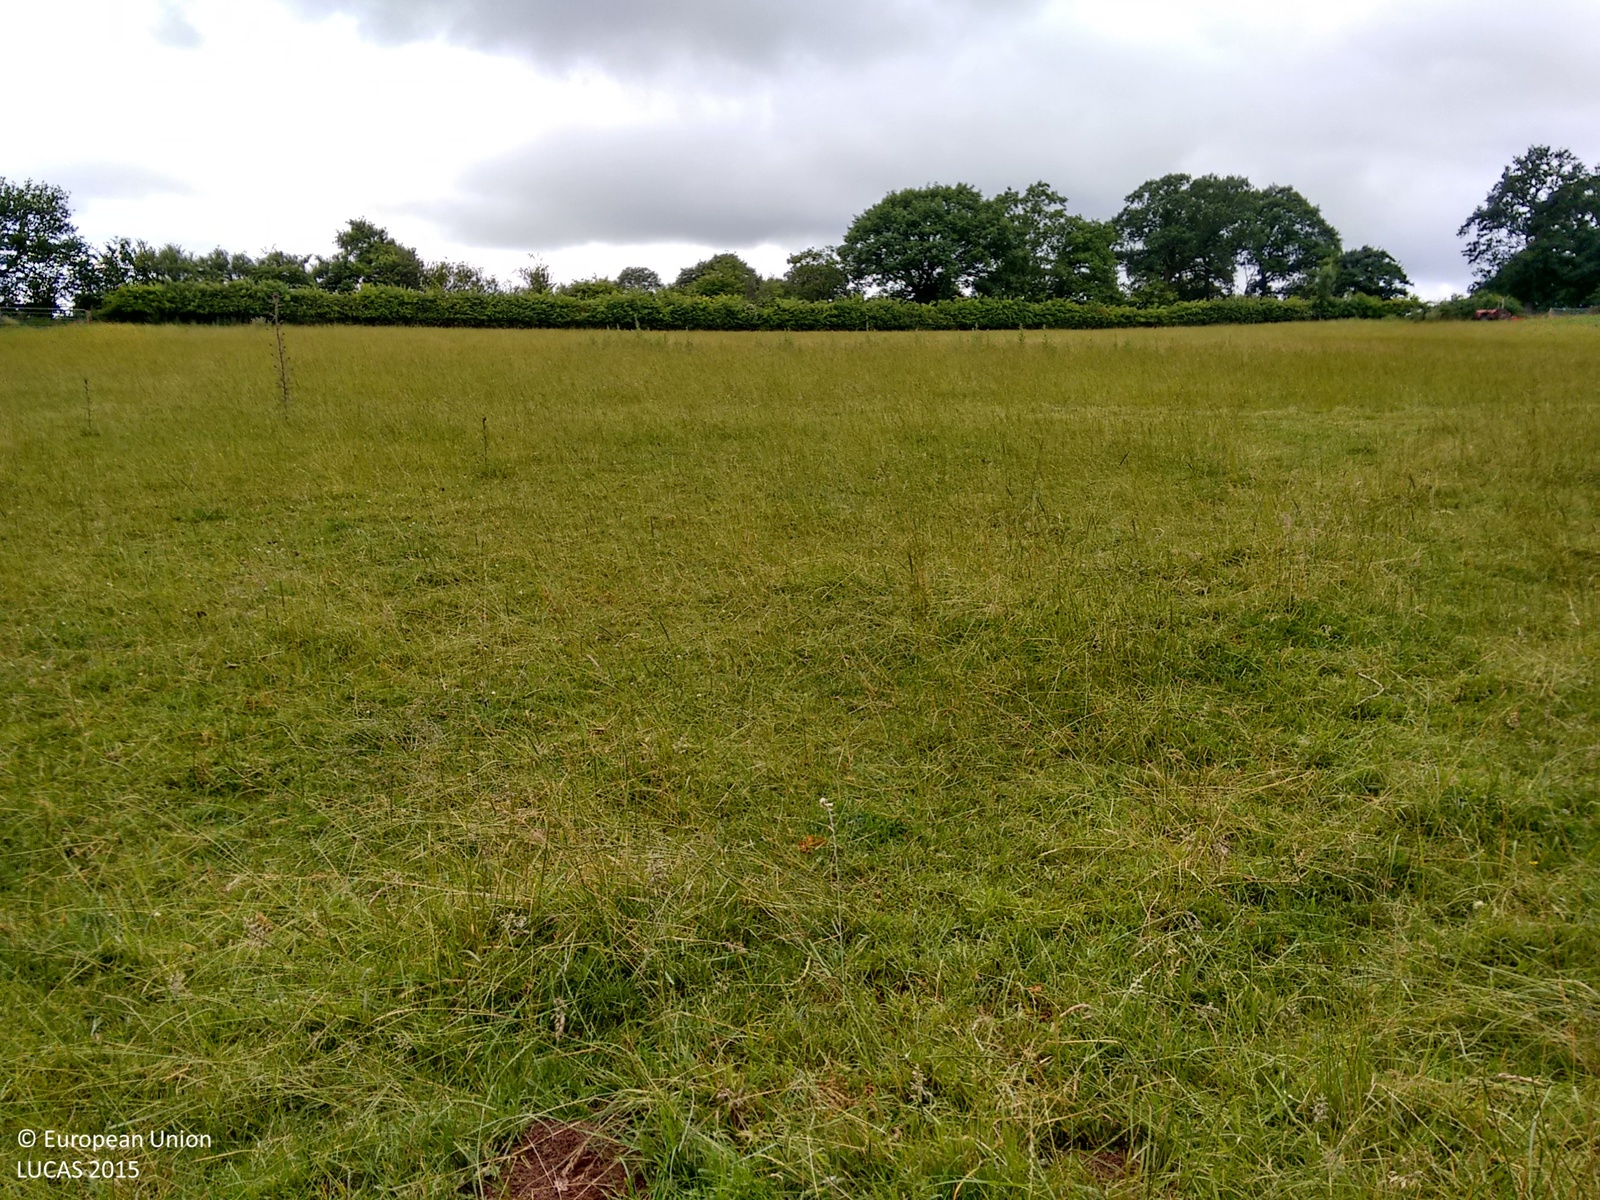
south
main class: Grassland
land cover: Grassland without tree/shrub cover
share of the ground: > 75 %
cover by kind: herbaceous plants 100 %
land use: Agriculture (excluding fallow land and kitchen gardens)
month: July
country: GB
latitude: 52.2144
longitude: -2.5815
